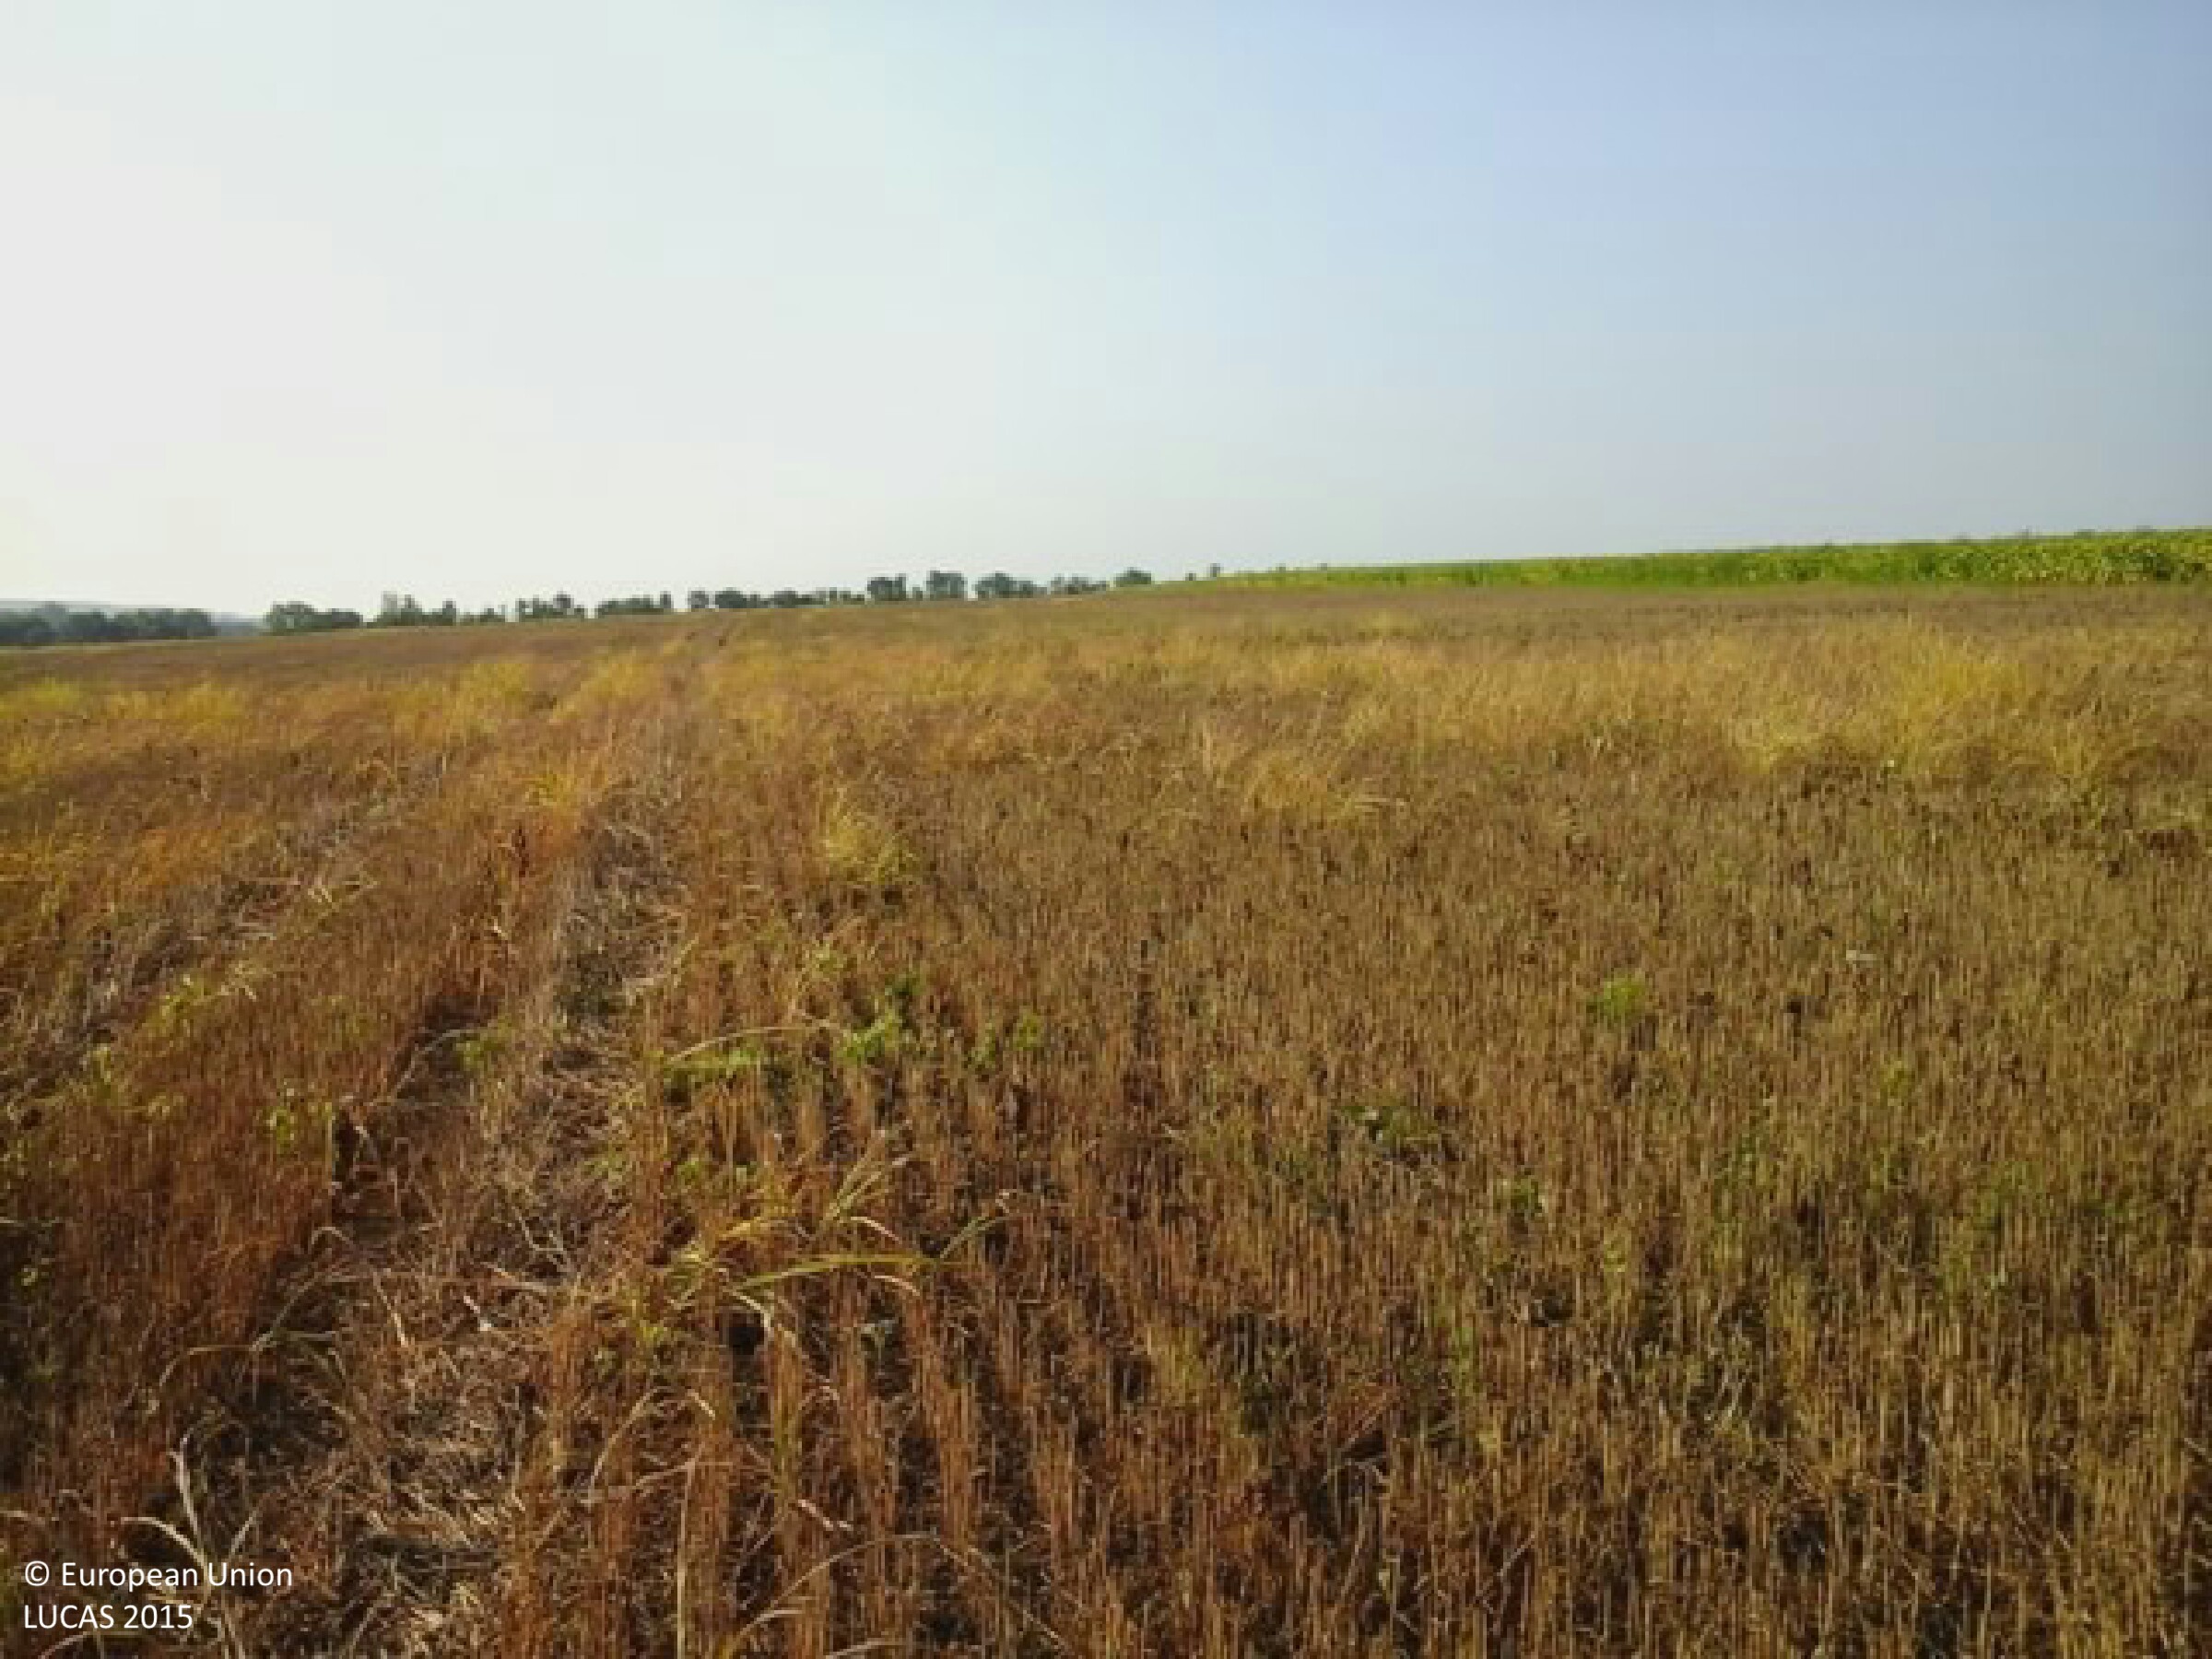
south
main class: Cropland
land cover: Common wheat
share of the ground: > 75 %
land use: Agriculture (excluding fallow land and kitchen gardens)
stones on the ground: < 10 %
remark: Harvested field
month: August
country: HU
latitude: 46.4560
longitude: 17.9098
